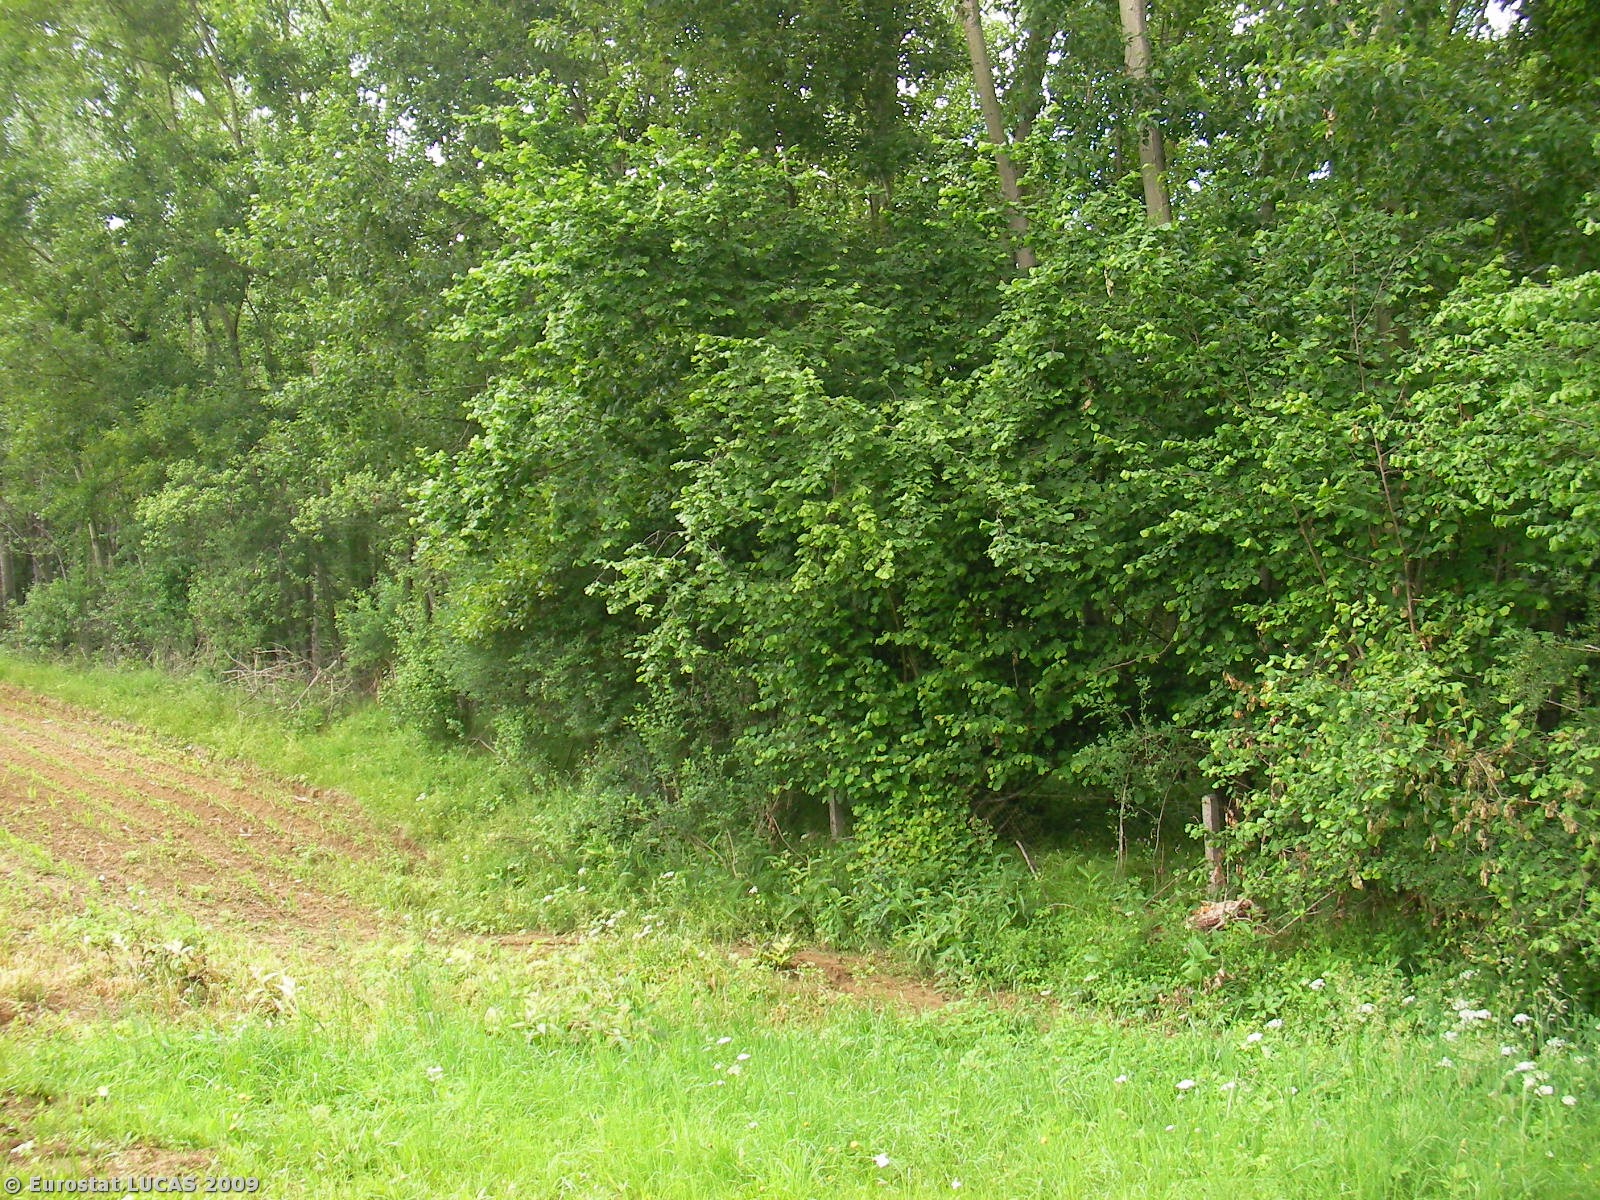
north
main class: Cropland
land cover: Maize
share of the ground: 10 - 25 %
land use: Agriculture (excluding fallow land and kitchen gardens)
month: June
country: AT
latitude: 47.1539
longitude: 15.7379
